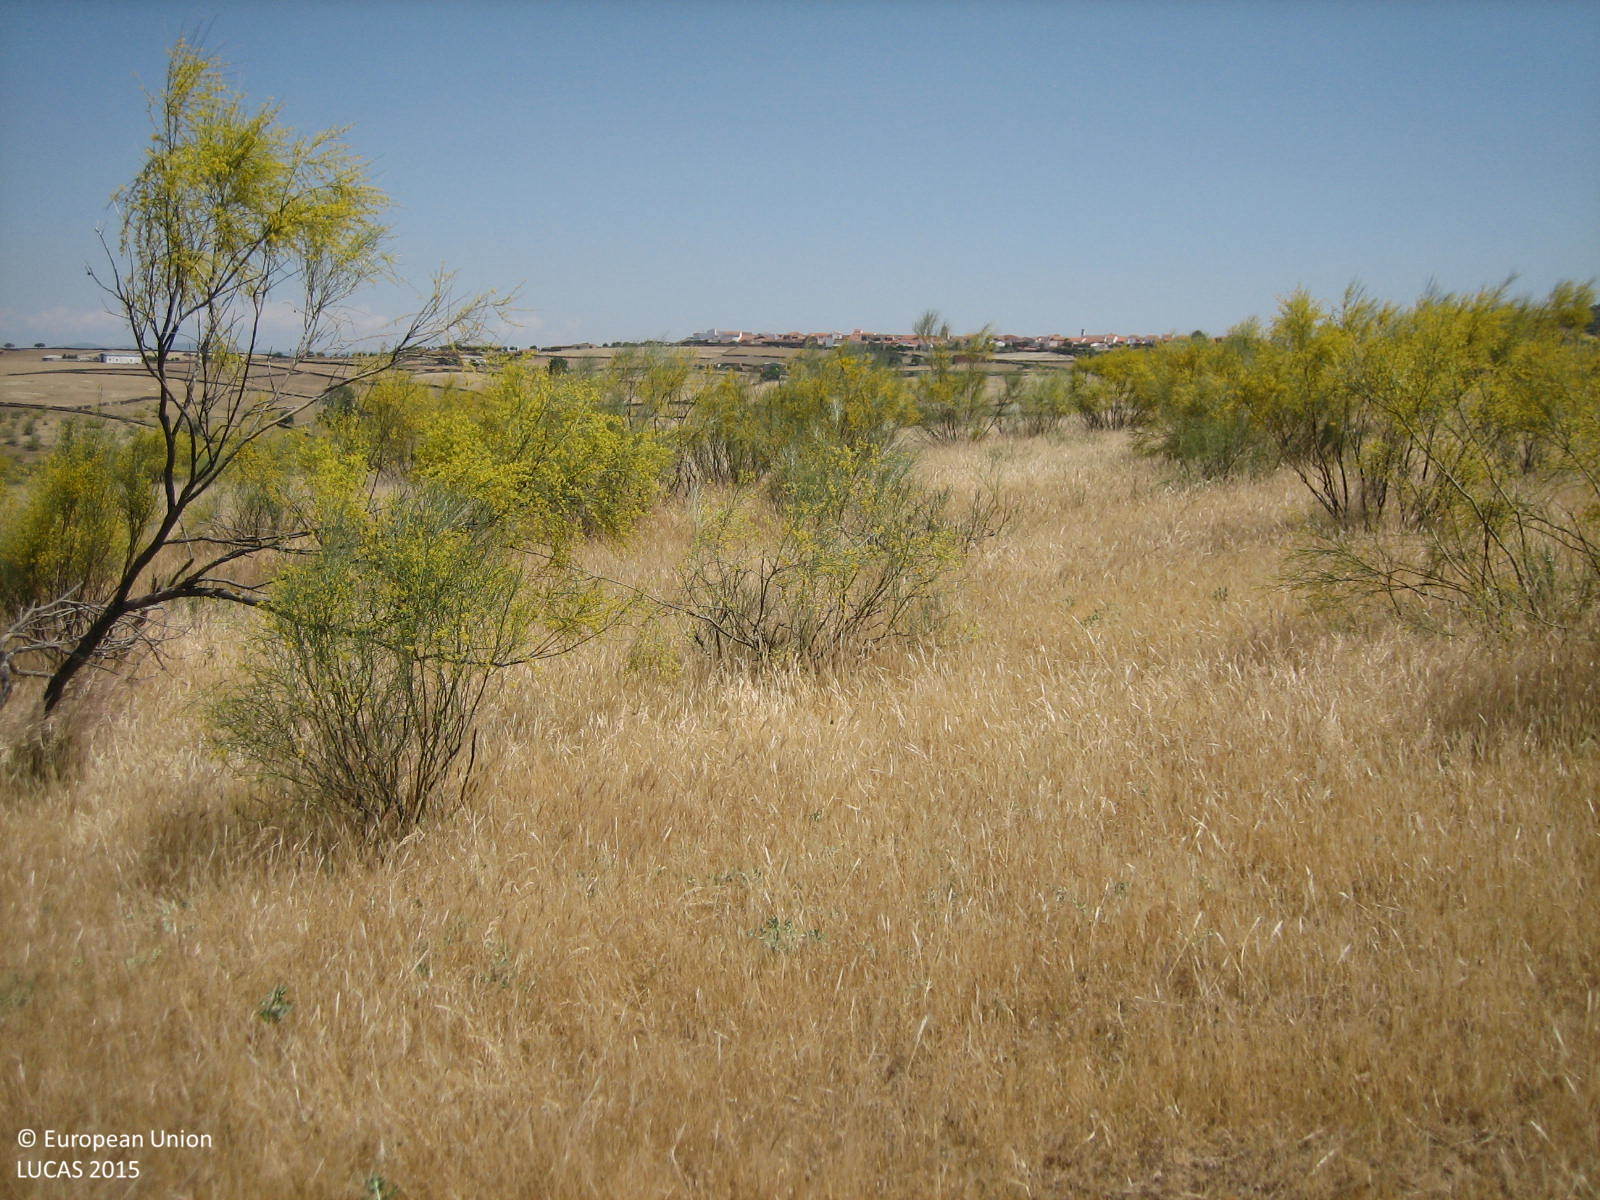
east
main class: Grassland
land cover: Grassland with sparse tree/shrub cover
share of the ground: > 75 %
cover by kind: herbaceous plants 90 %, broadleaved forest trees 5 %, shrubs 5 %
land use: Agriculture (excluding fallow land and kitchen gardens)
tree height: < 5 m
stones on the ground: < 10 %
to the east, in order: Grassland with sparse tree/shrub cover; Tracks; Grassland with sparse tree/shrub cover
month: May
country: ES
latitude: 38.9167
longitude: -5.1568
